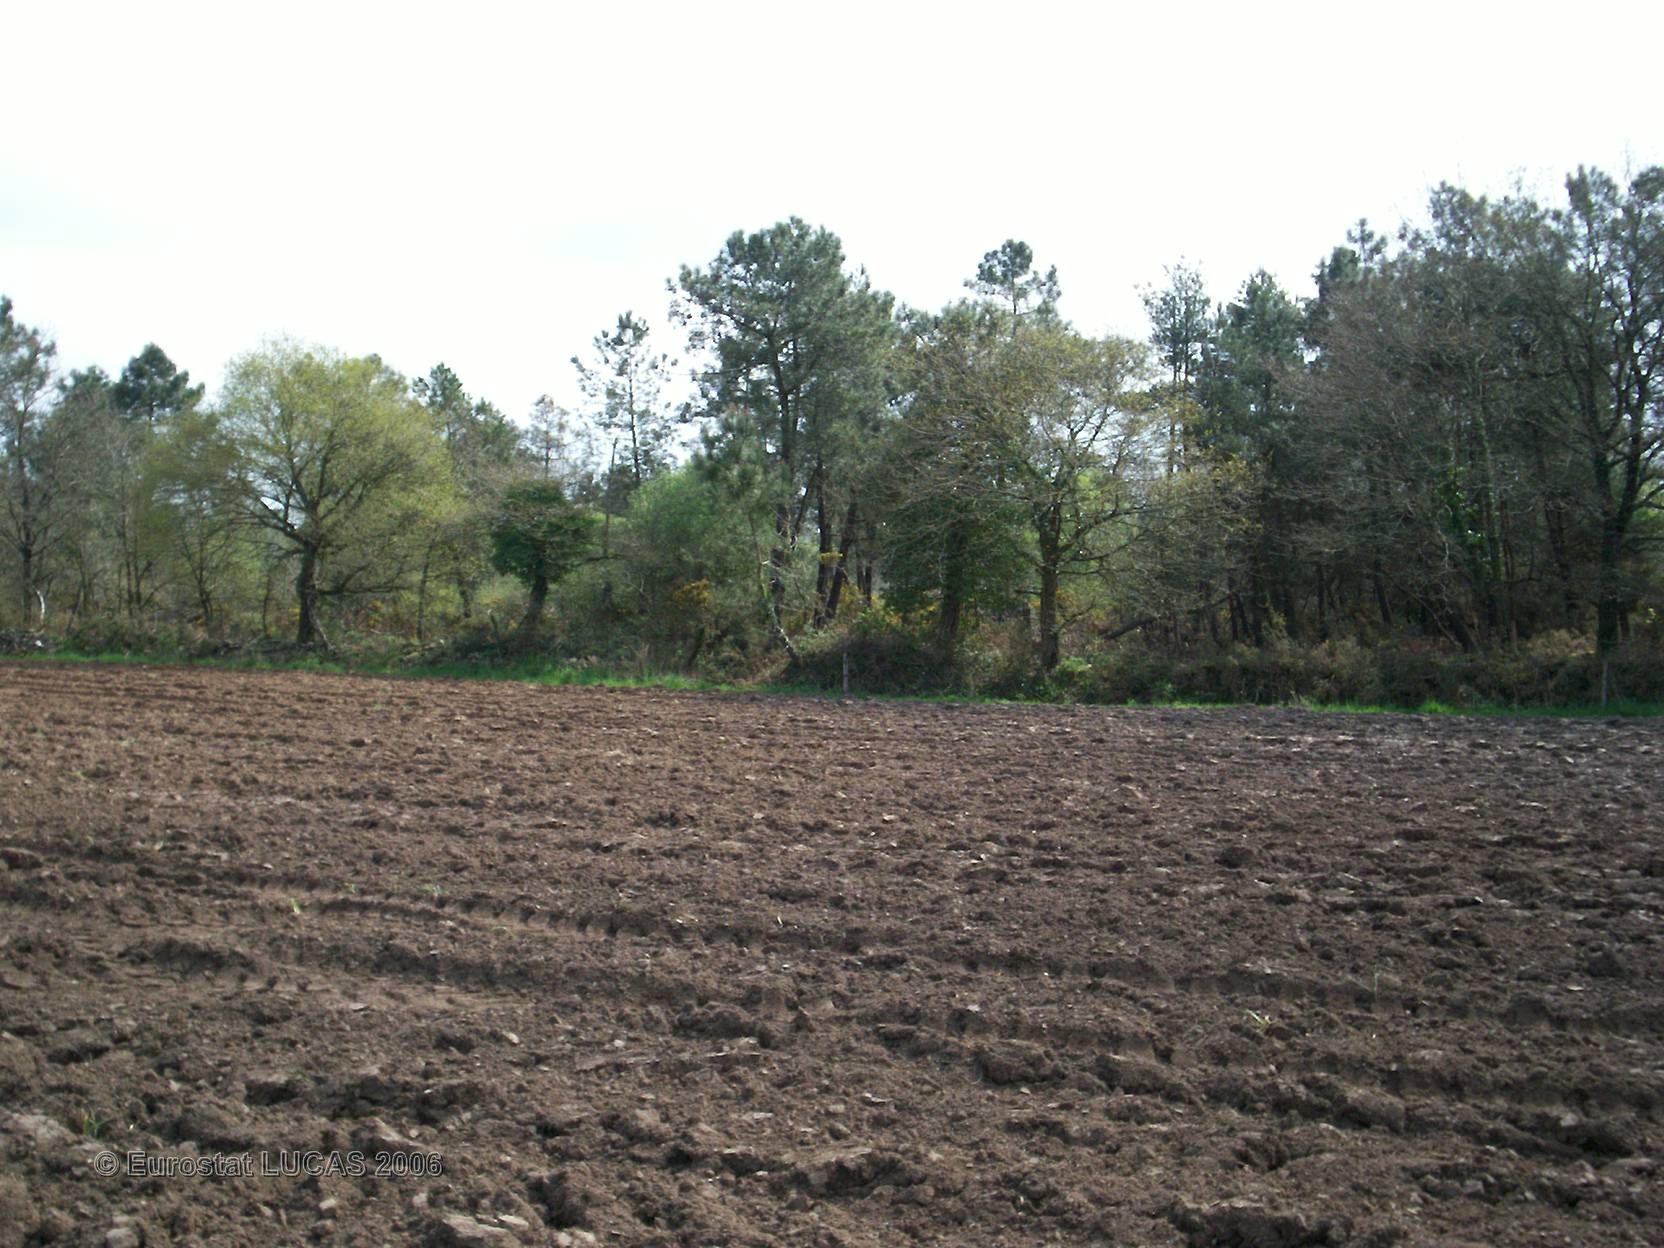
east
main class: Cropland
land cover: Maize
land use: Agriculture (excluding fallow land and kitchen gardens)
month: May
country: FR
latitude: 47.8030
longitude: -2.7876
